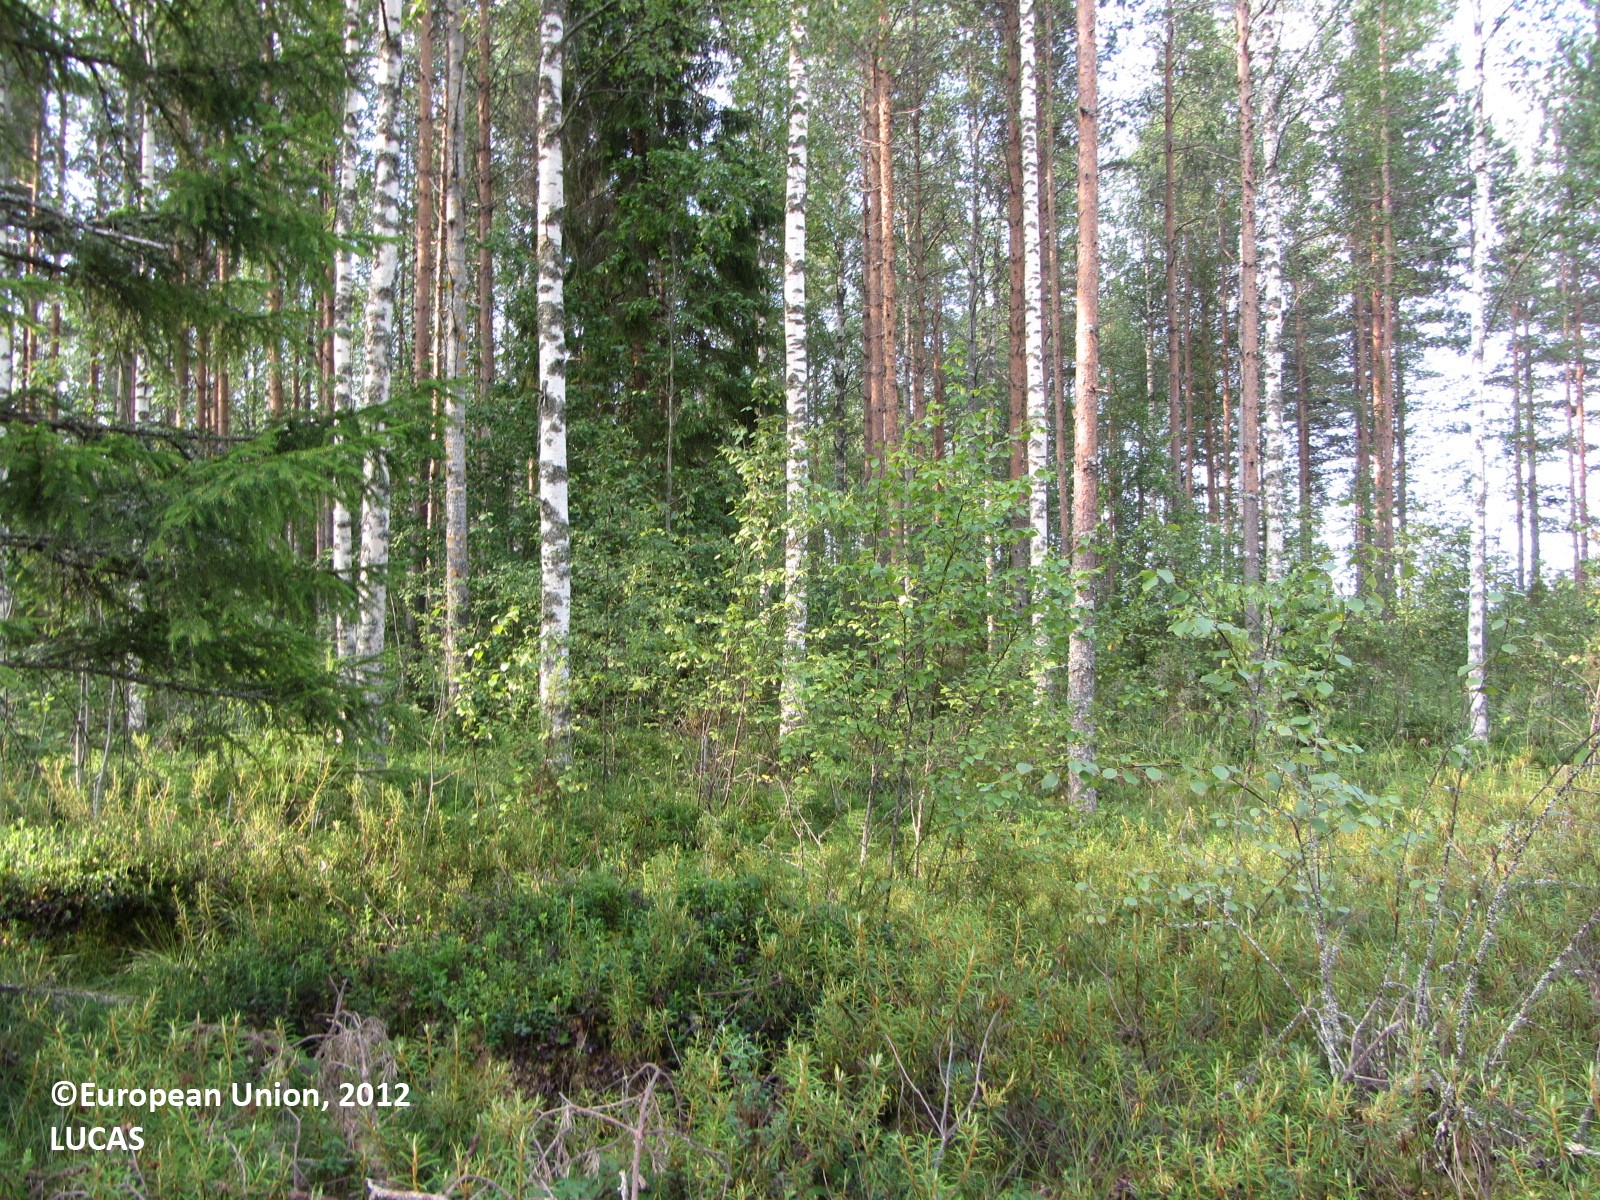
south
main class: Woodland
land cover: Pine dominated mixed woodland
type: boreal forest
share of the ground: 50 - 75 %
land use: Forestry
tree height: > 5 m
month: July
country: FI
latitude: 63.5742
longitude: 24.5611
